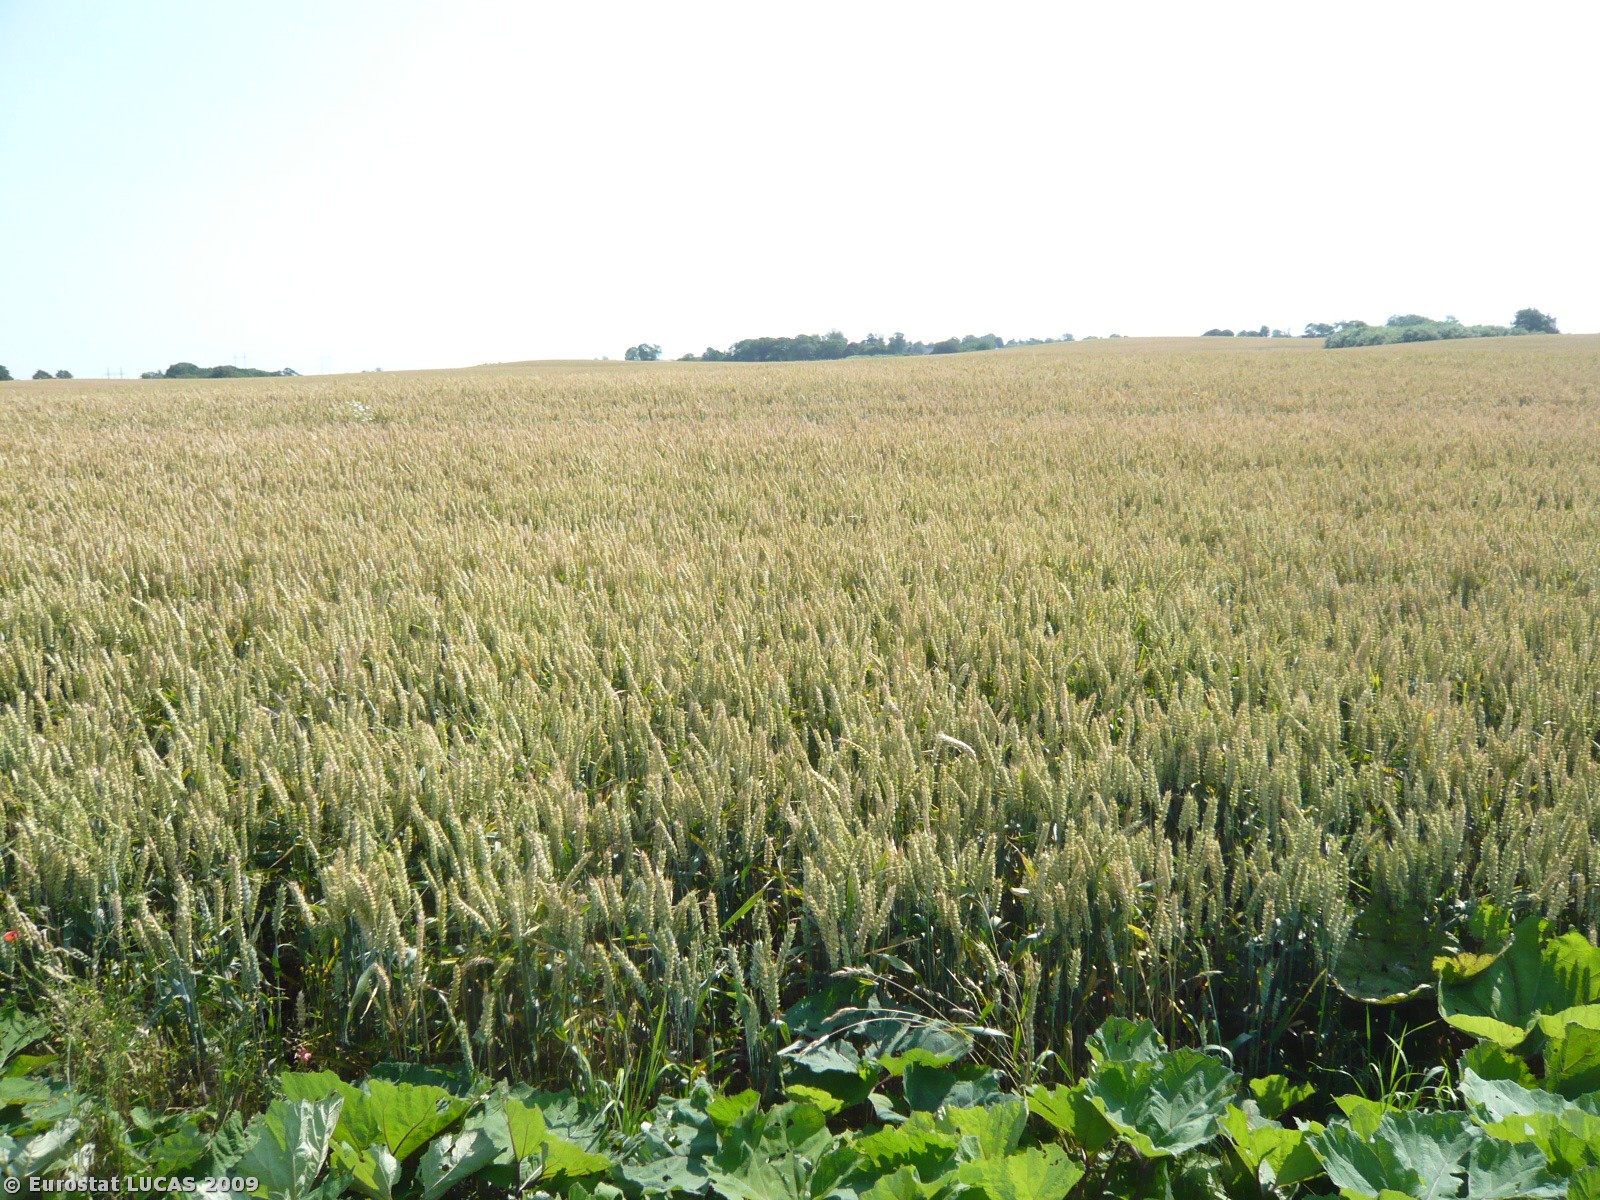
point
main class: Cropland
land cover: Common wheat
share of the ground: > 75 %
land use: Agriculture (excluding fallow land and kitchen gardens)
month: July
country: DK
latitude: 55.5806
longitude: 11.8861
